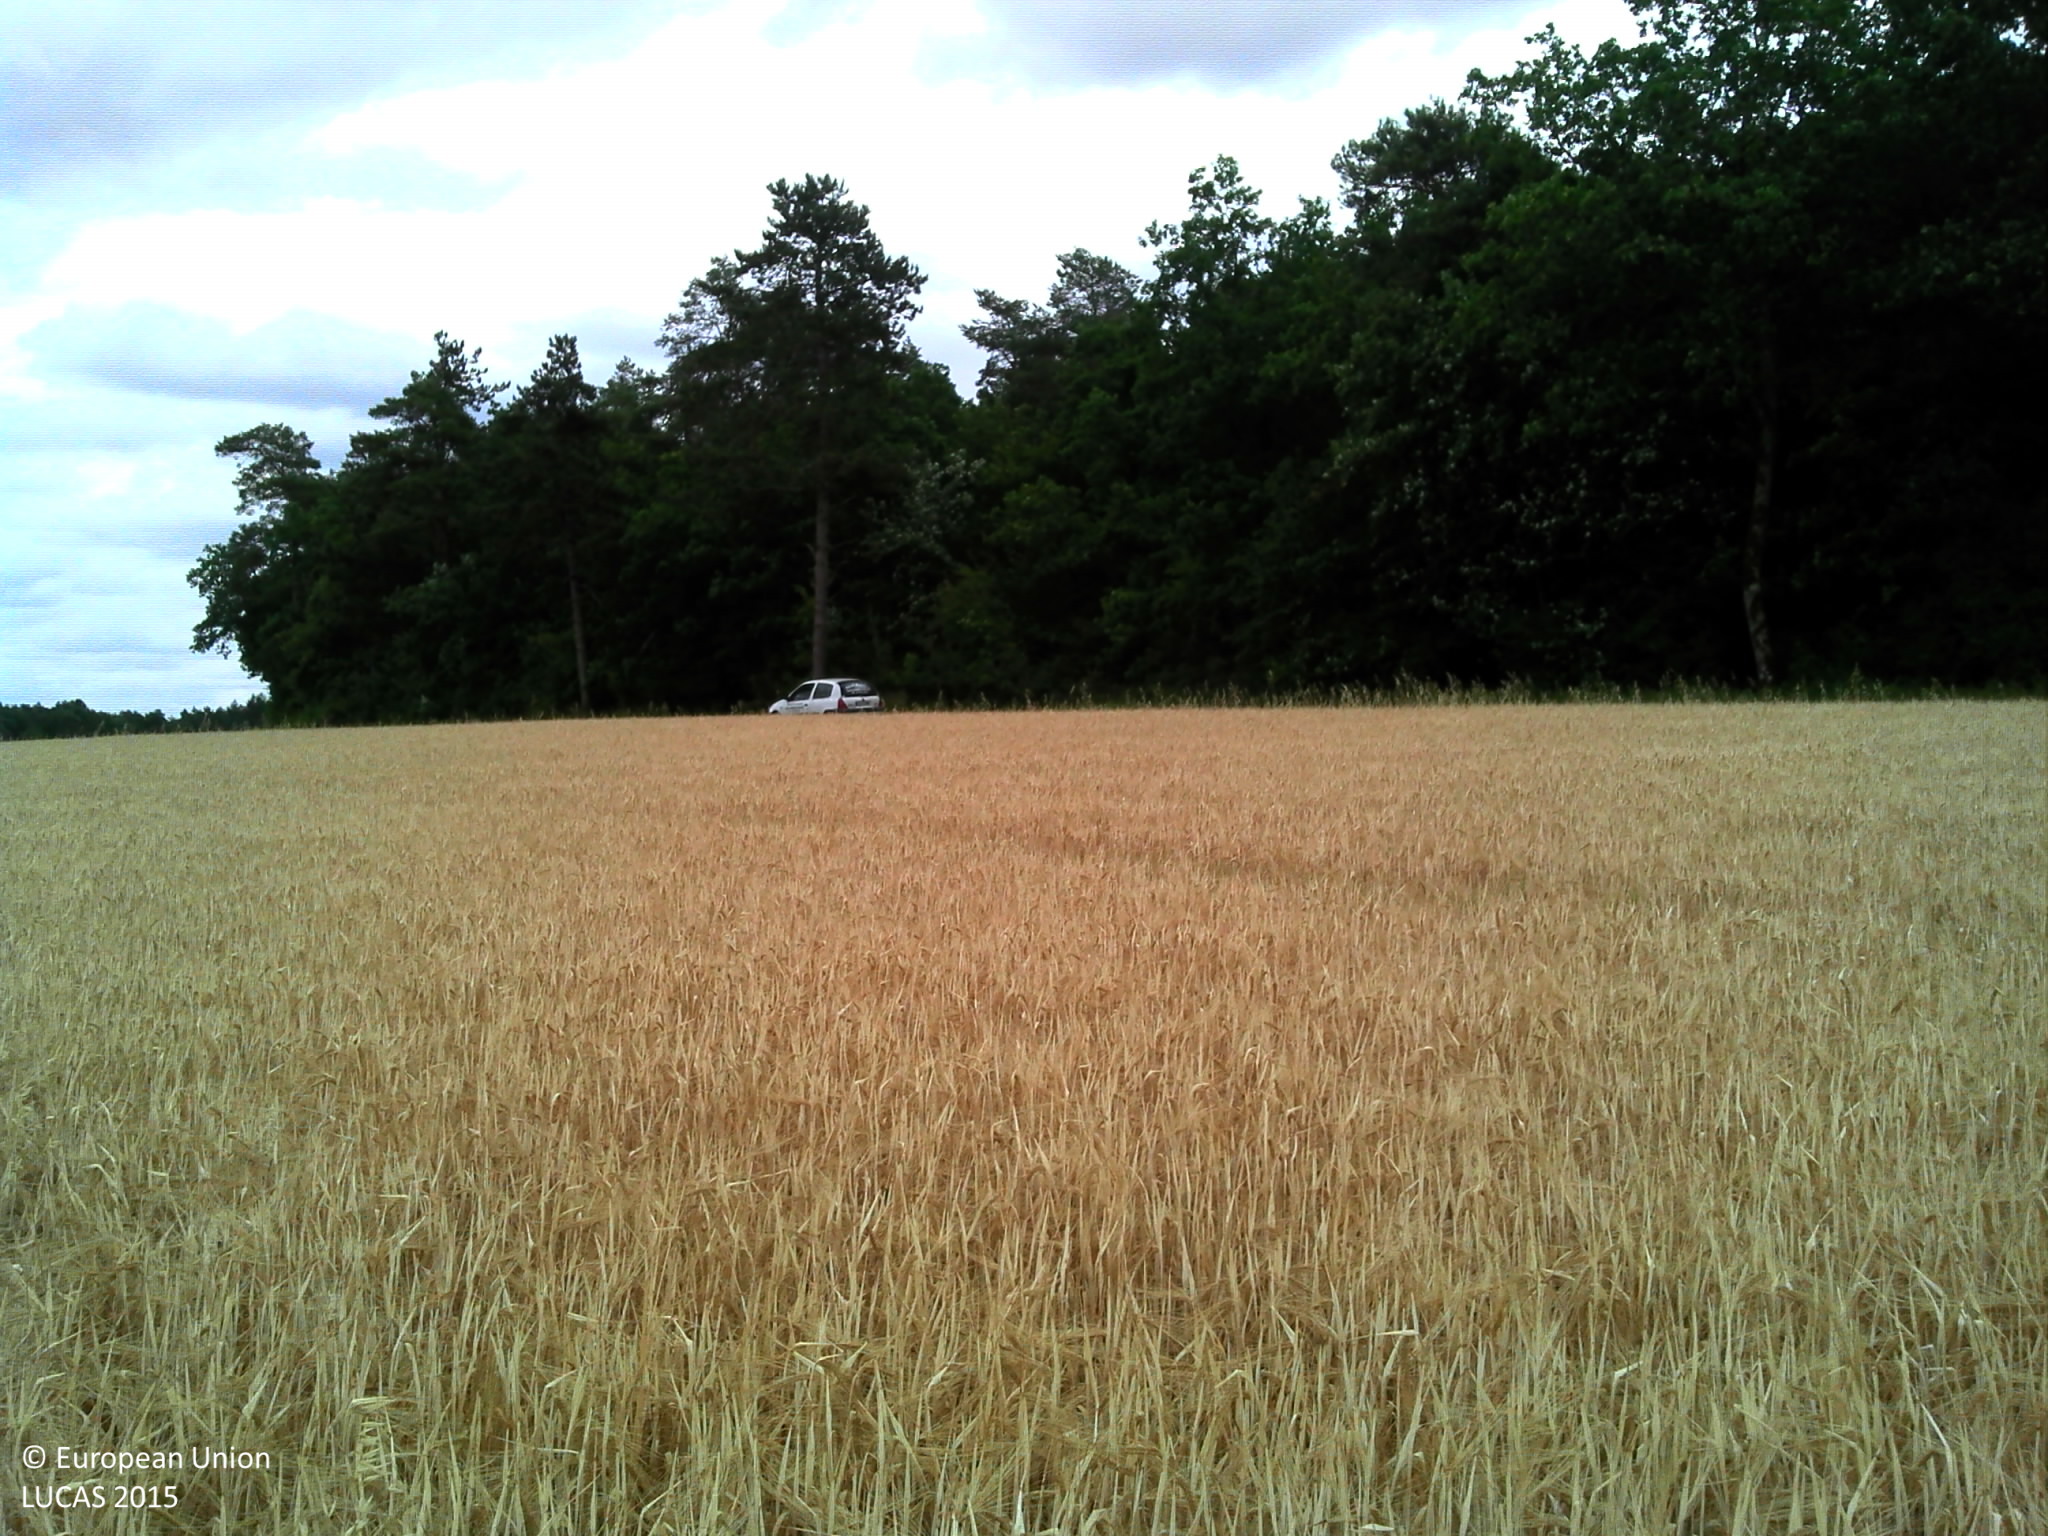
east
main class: Cropland
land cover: Barley
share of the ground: > 75 %
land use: Agriculture (excluding fallow land and kitchen gardens)
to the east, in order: Barley; Grass margins; Tracks; Grass margins; Broadleaved woodland
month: July
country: FR
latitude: 48.1527
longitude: 5.1465
